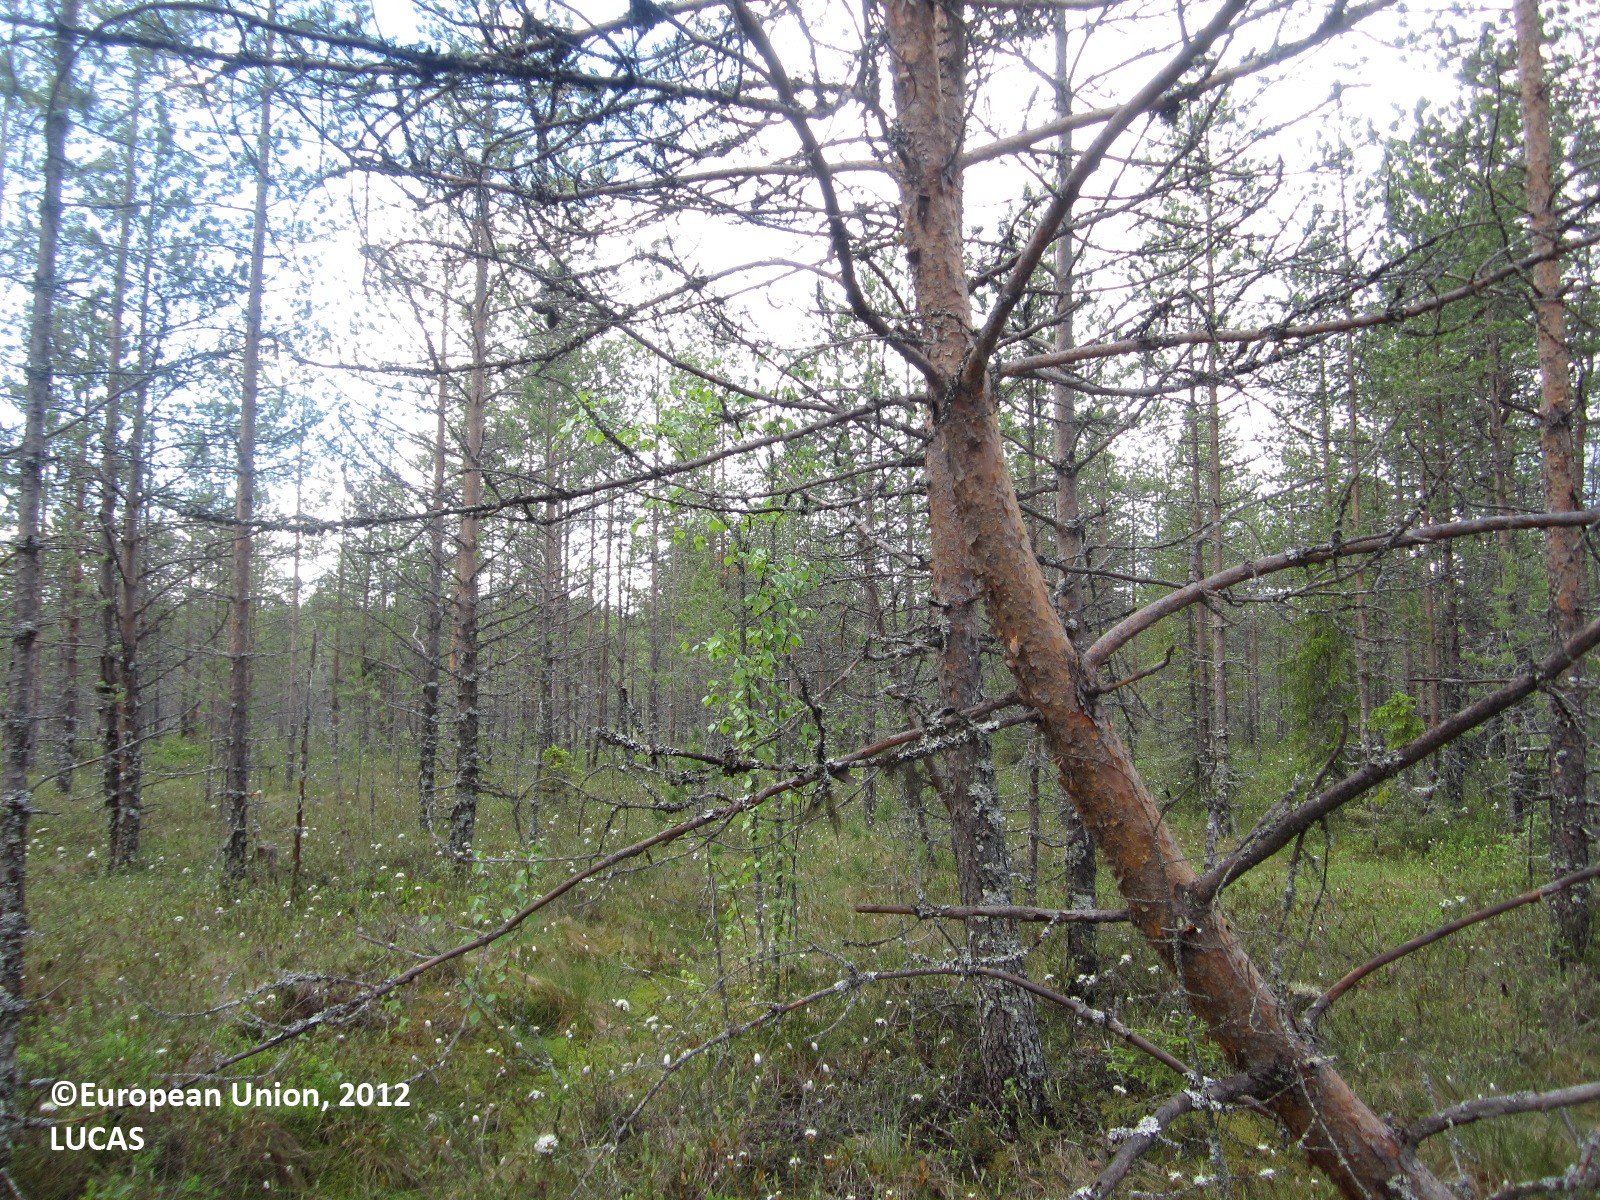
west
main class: Woodland
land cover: Pine dominated coniferous woodland
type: boreal forest
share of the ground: 50 - 75 %
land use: Forestry
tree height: > 5 m
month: June
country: FI
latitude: 64.4158
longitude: 29.7118
